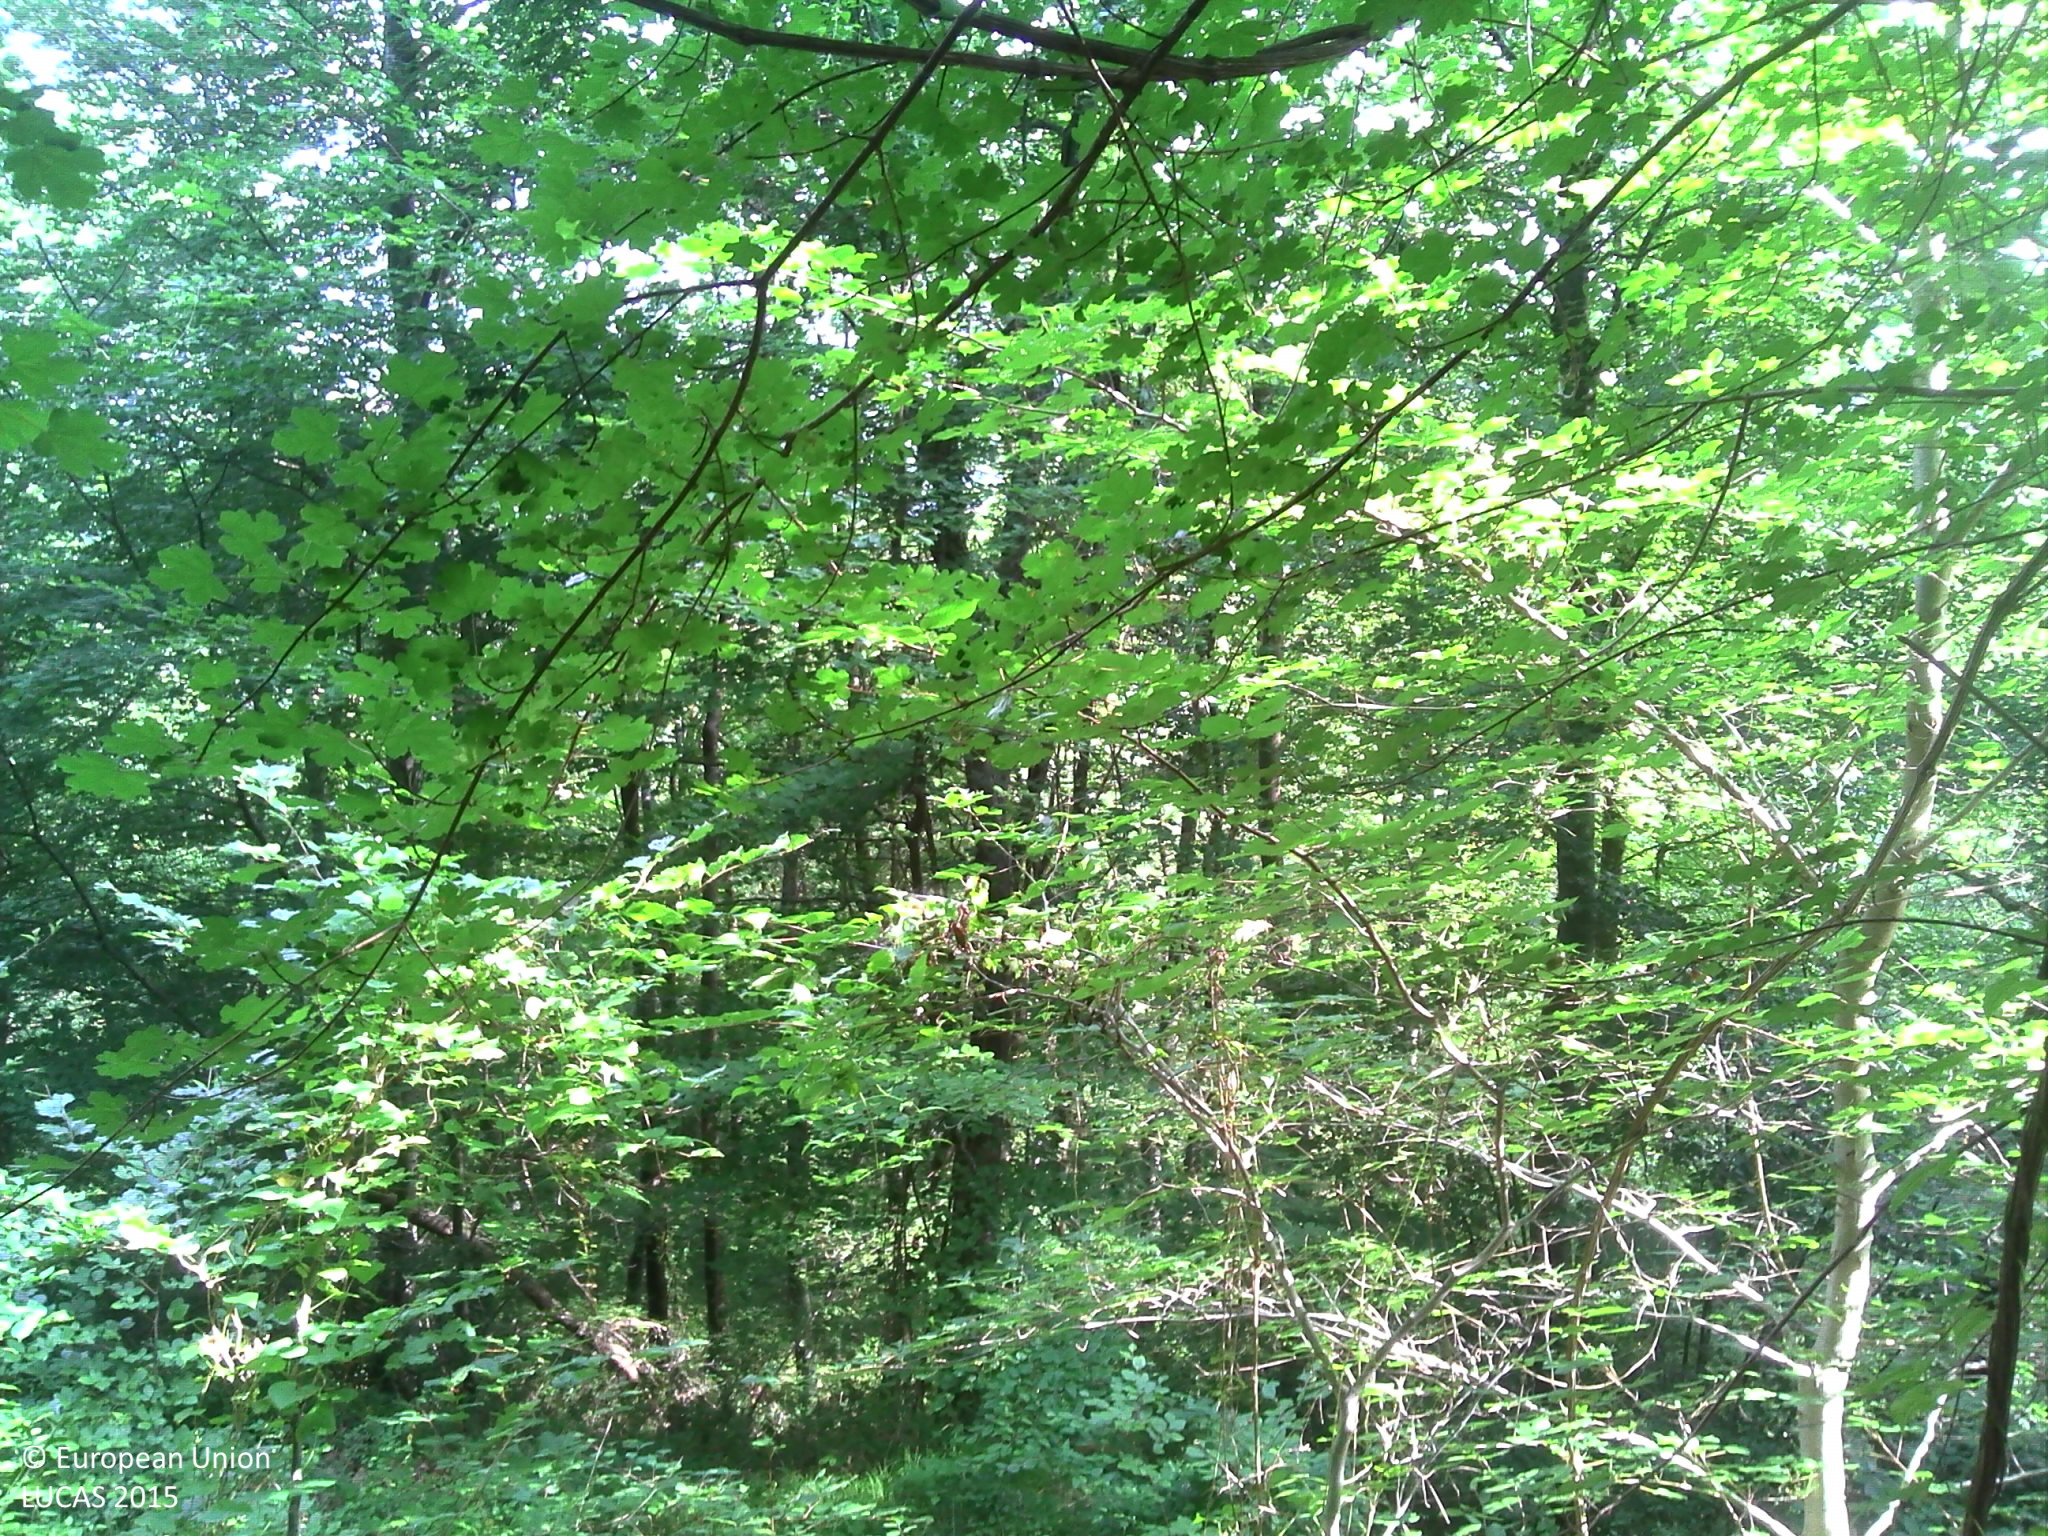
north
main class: Woodland
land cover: Broadleaved woodland
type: acidophilous oak and oak-birch forest
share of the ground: > 75 %
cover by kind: broadleaved forest trees 100 %
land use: Forestry
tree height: > 5 m
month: July
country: FR
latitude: 43.1615
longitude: 1.0125
